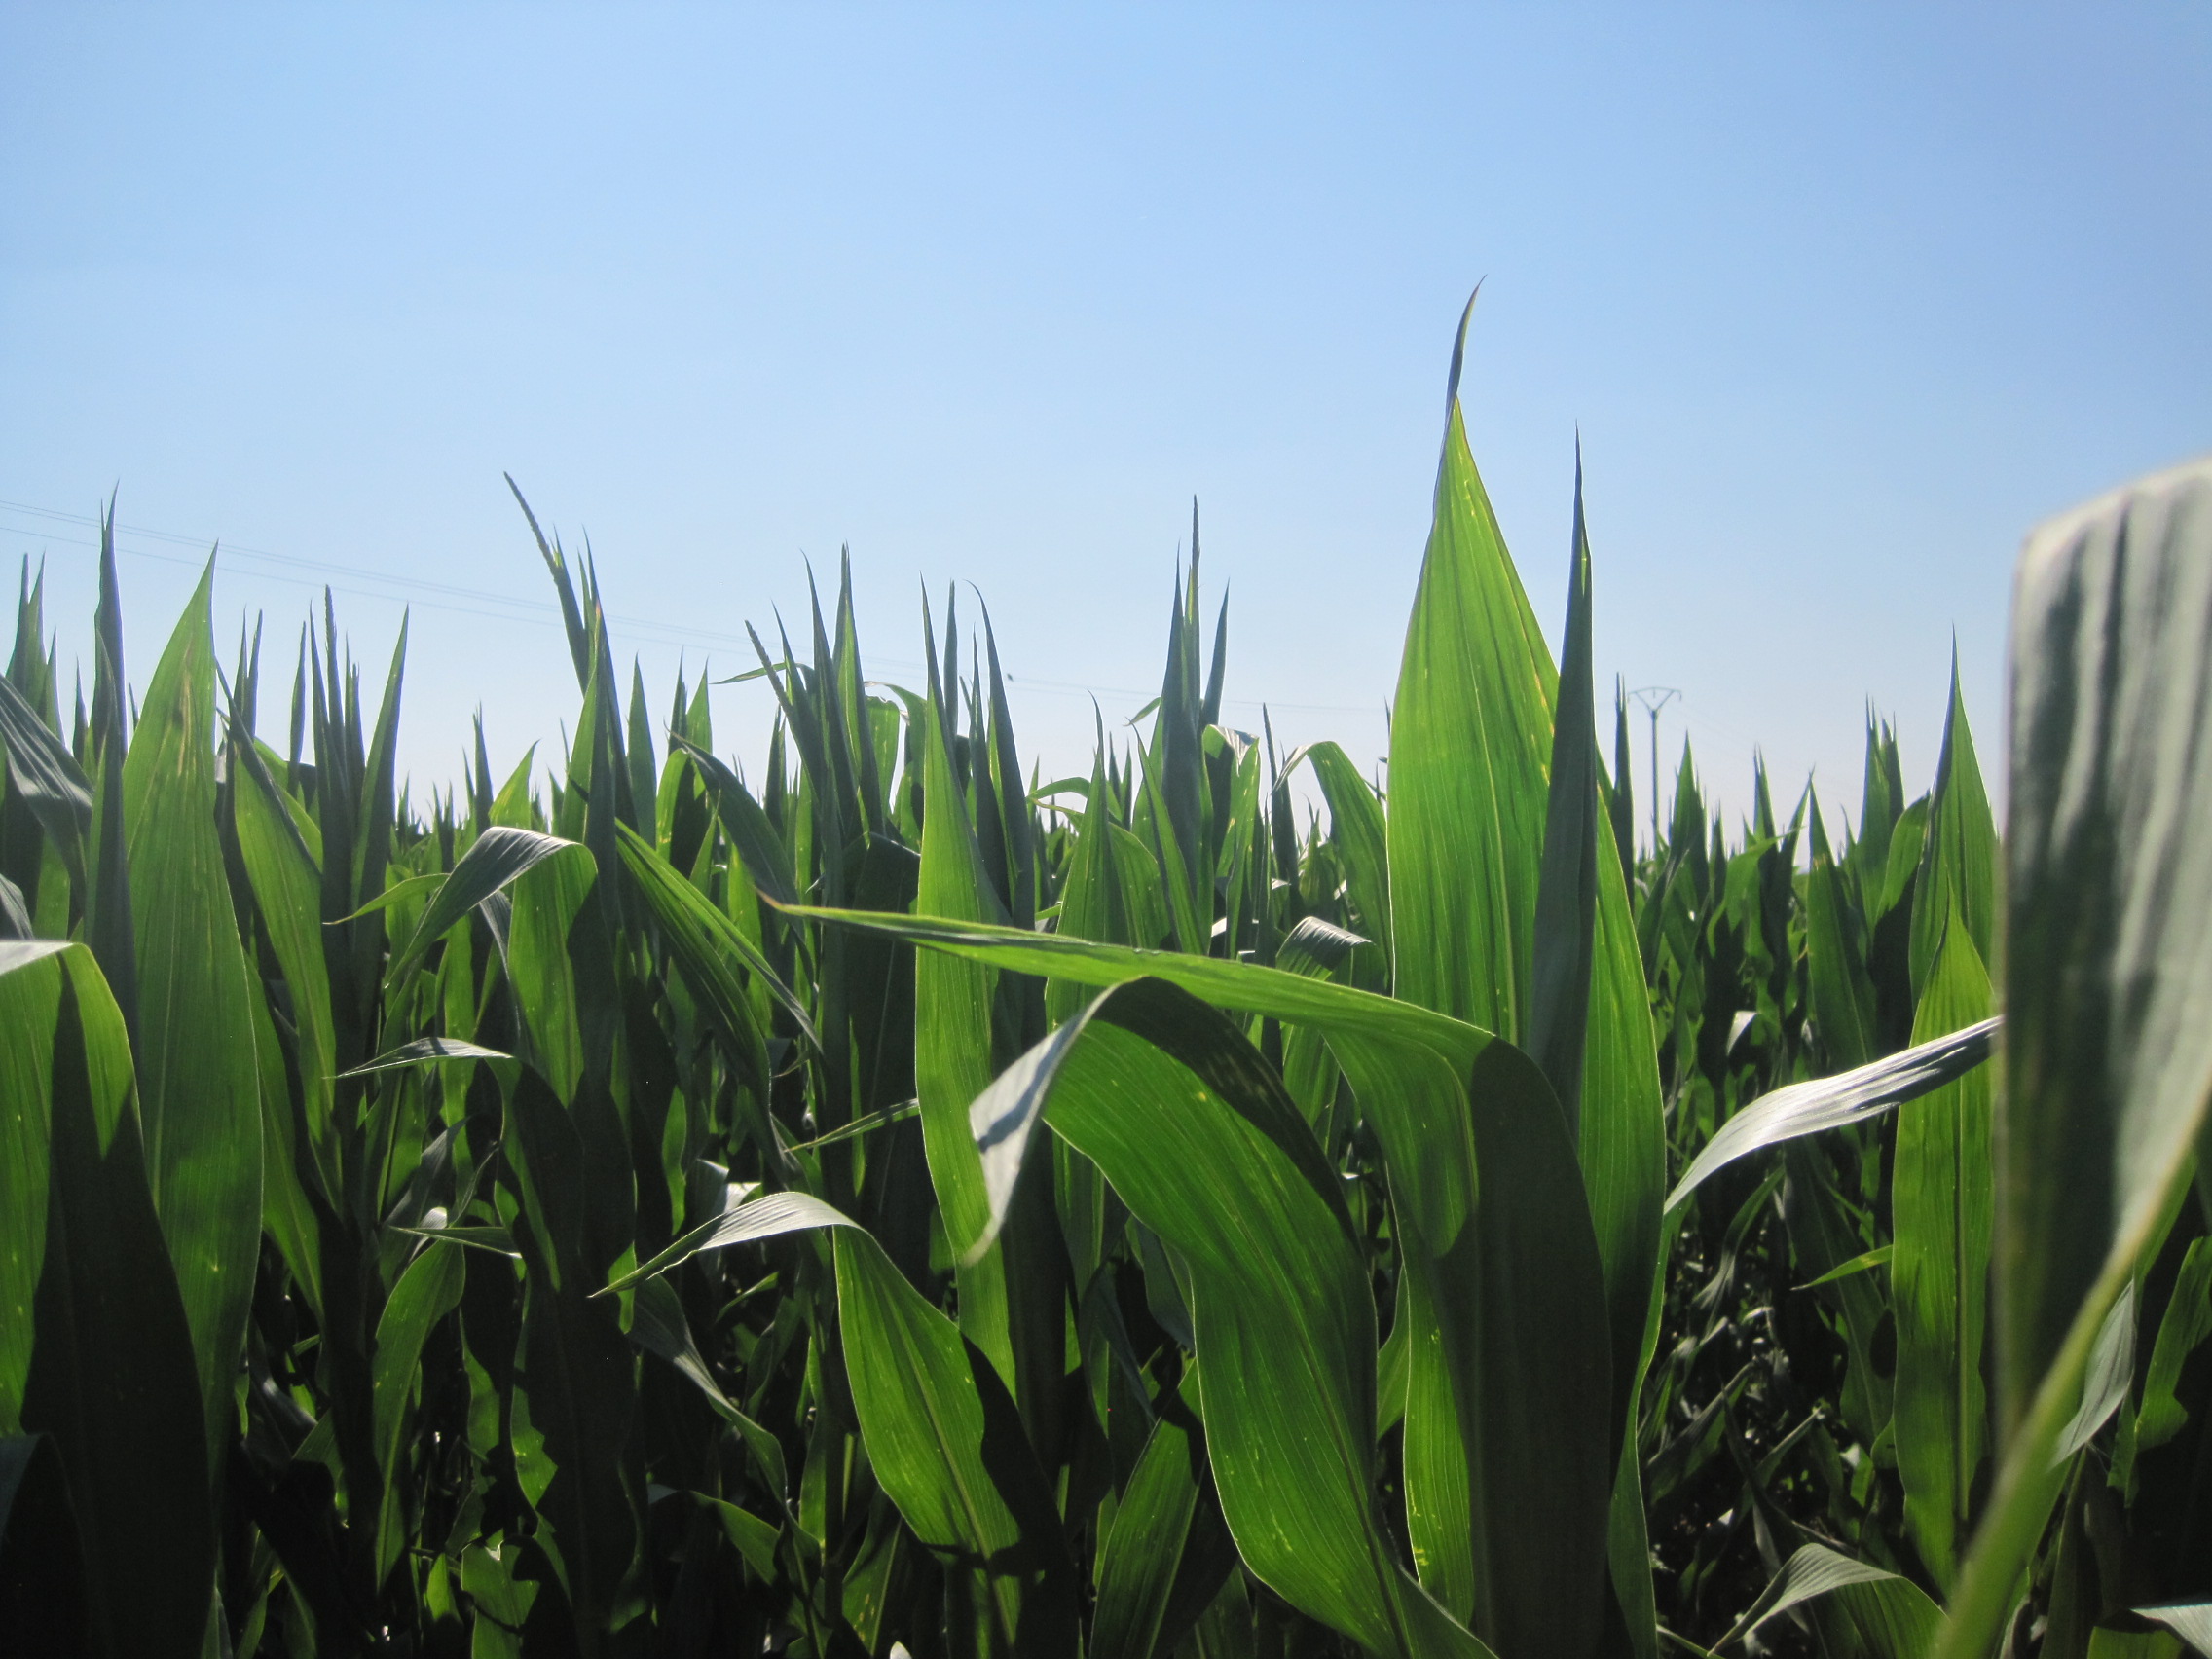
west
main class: Cropland
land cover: Maize
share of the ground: > 75 %
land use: Agriculture (excluding fallow land and kitchen gardens)
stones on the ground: 10 - 25 %
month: July
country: ES
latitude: 41.7351
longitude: -5.2162
